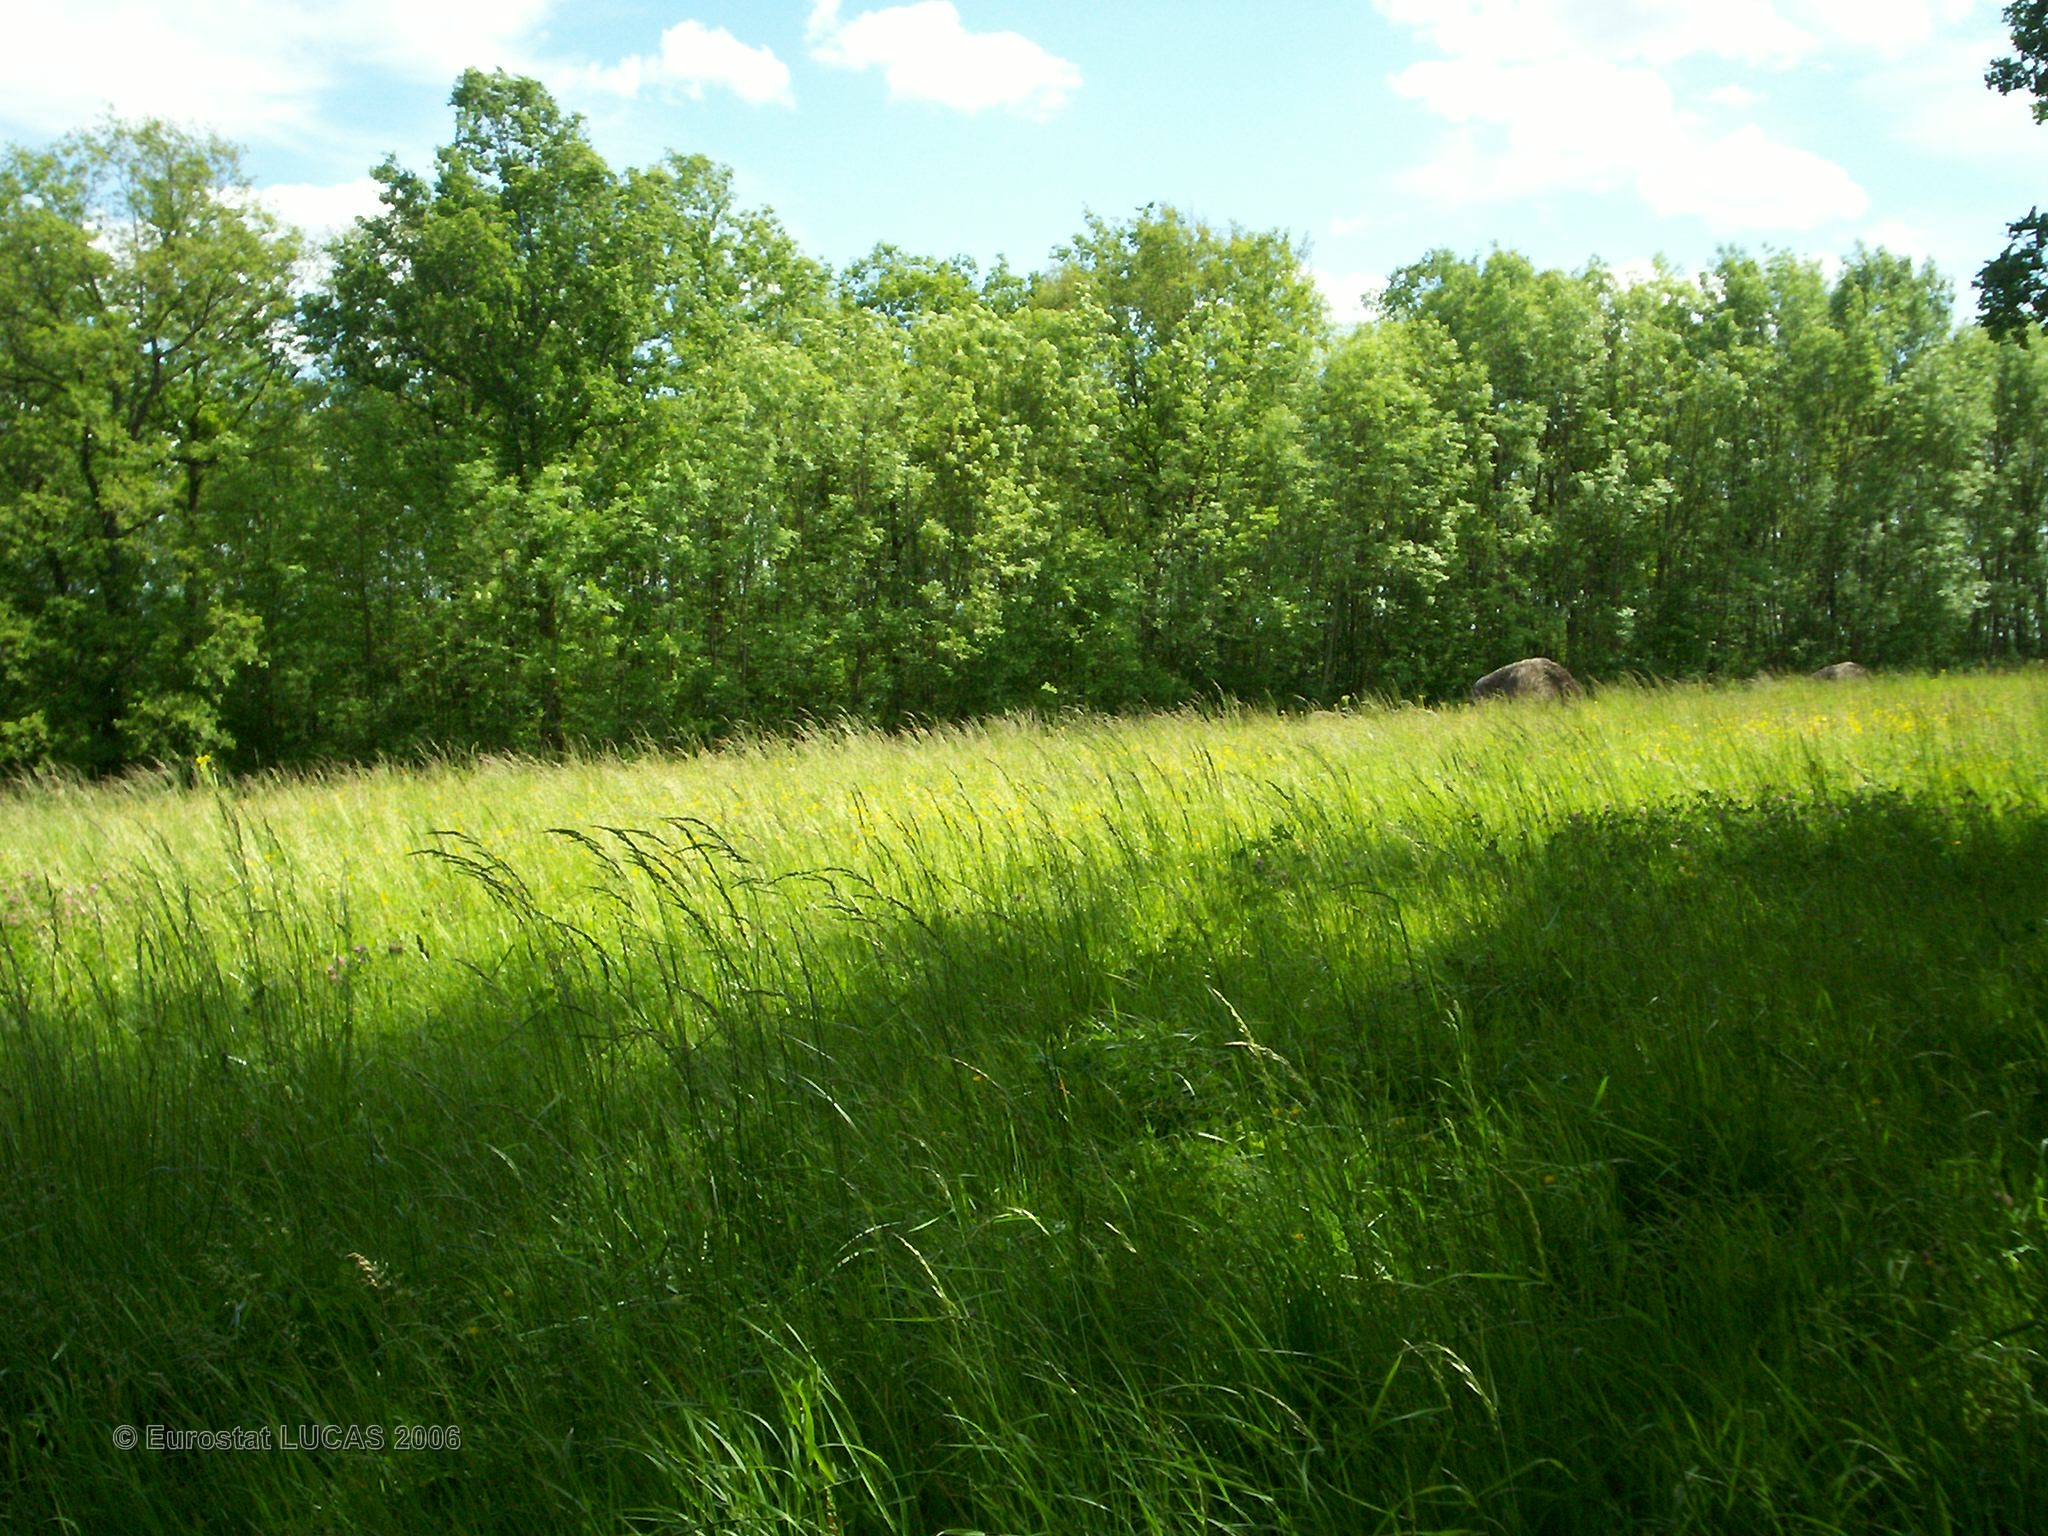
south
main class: Grassland
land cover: Grassland without tree/shrub cover
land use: Agriculture (excluding fallow land and kitchen gardens)
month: May
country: FR
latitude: 47.5371
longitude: 4.0064
